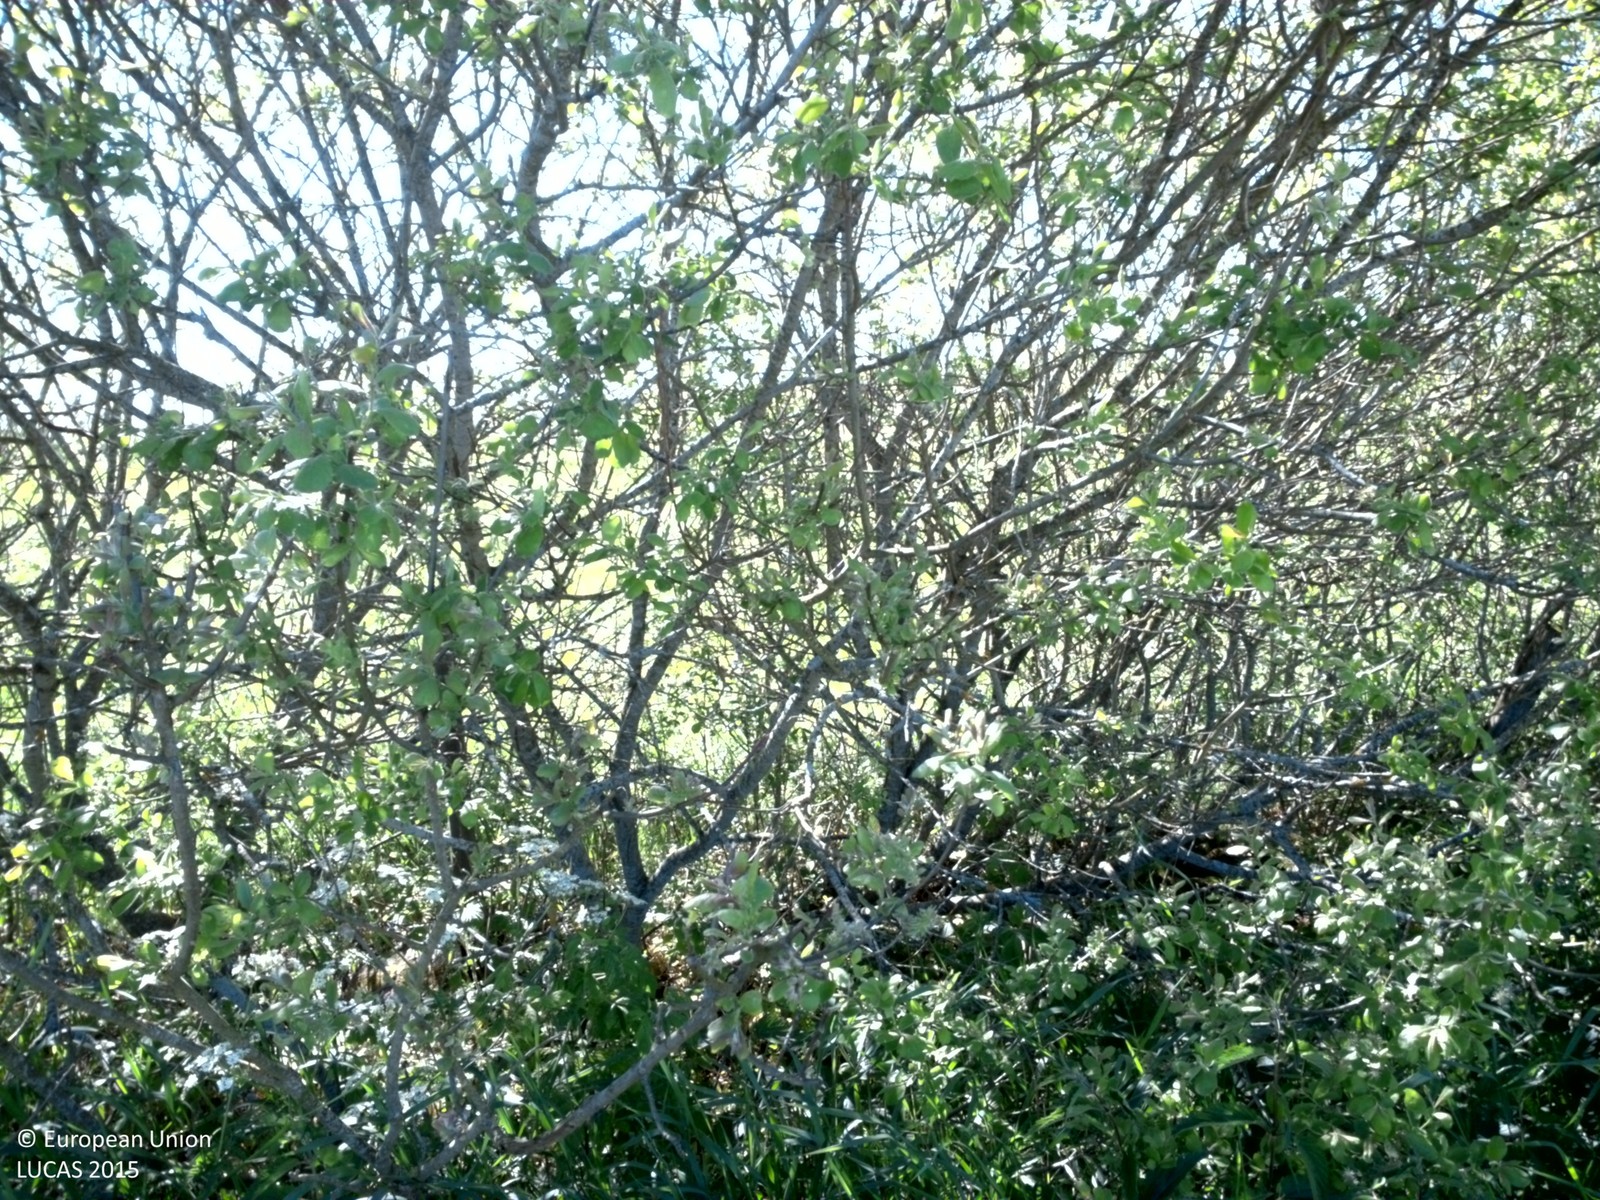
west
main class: Cropland
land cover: Other leguminous and mixtures for fodder
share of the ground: > 75 %
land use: Agriculture (excluding fallow land and kitchen gardens)
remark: Harvested field
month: June
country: SE
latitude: 58.4297
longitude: 14.0181
